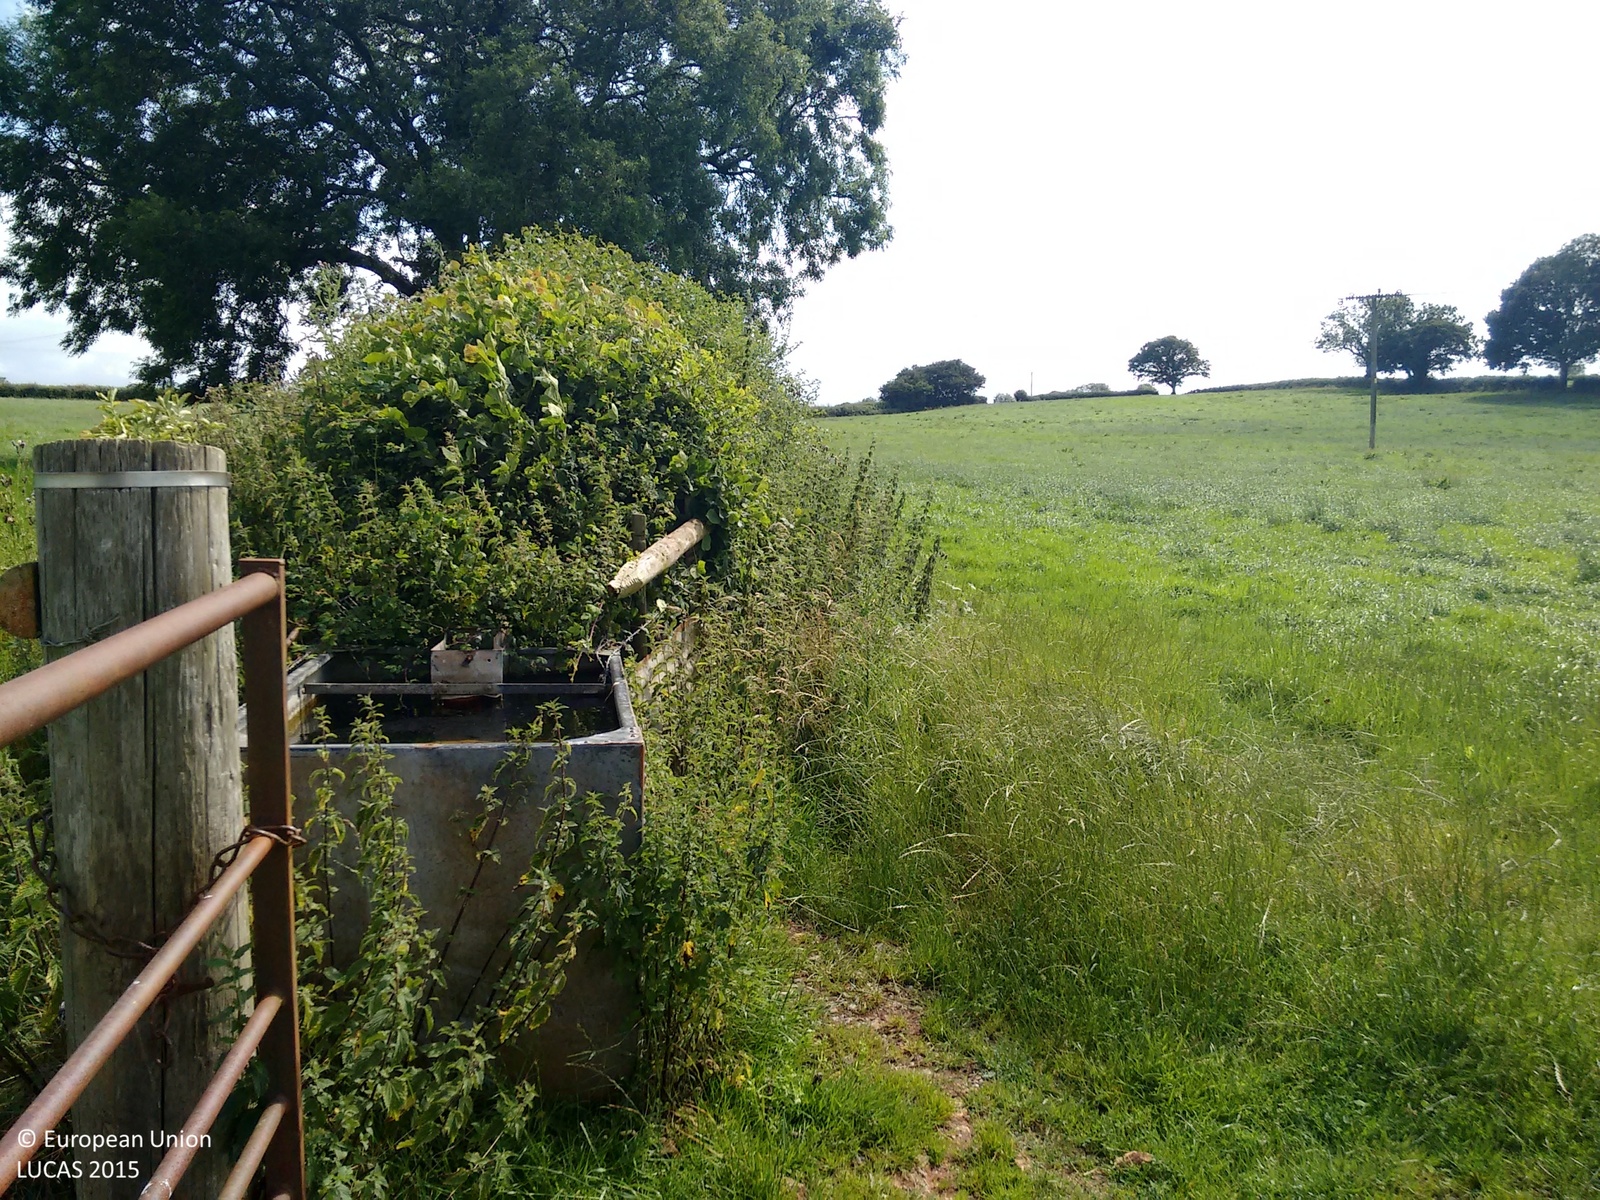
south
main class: Grassland
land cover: Grassland without tree/shrub cover
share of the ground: > 75 %
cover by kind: herbaceous plants 100 %
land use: Agriculture (excluding fallow land and kitchen gardens)
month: July
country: GB
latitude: 51.2565
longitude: -2.5187
